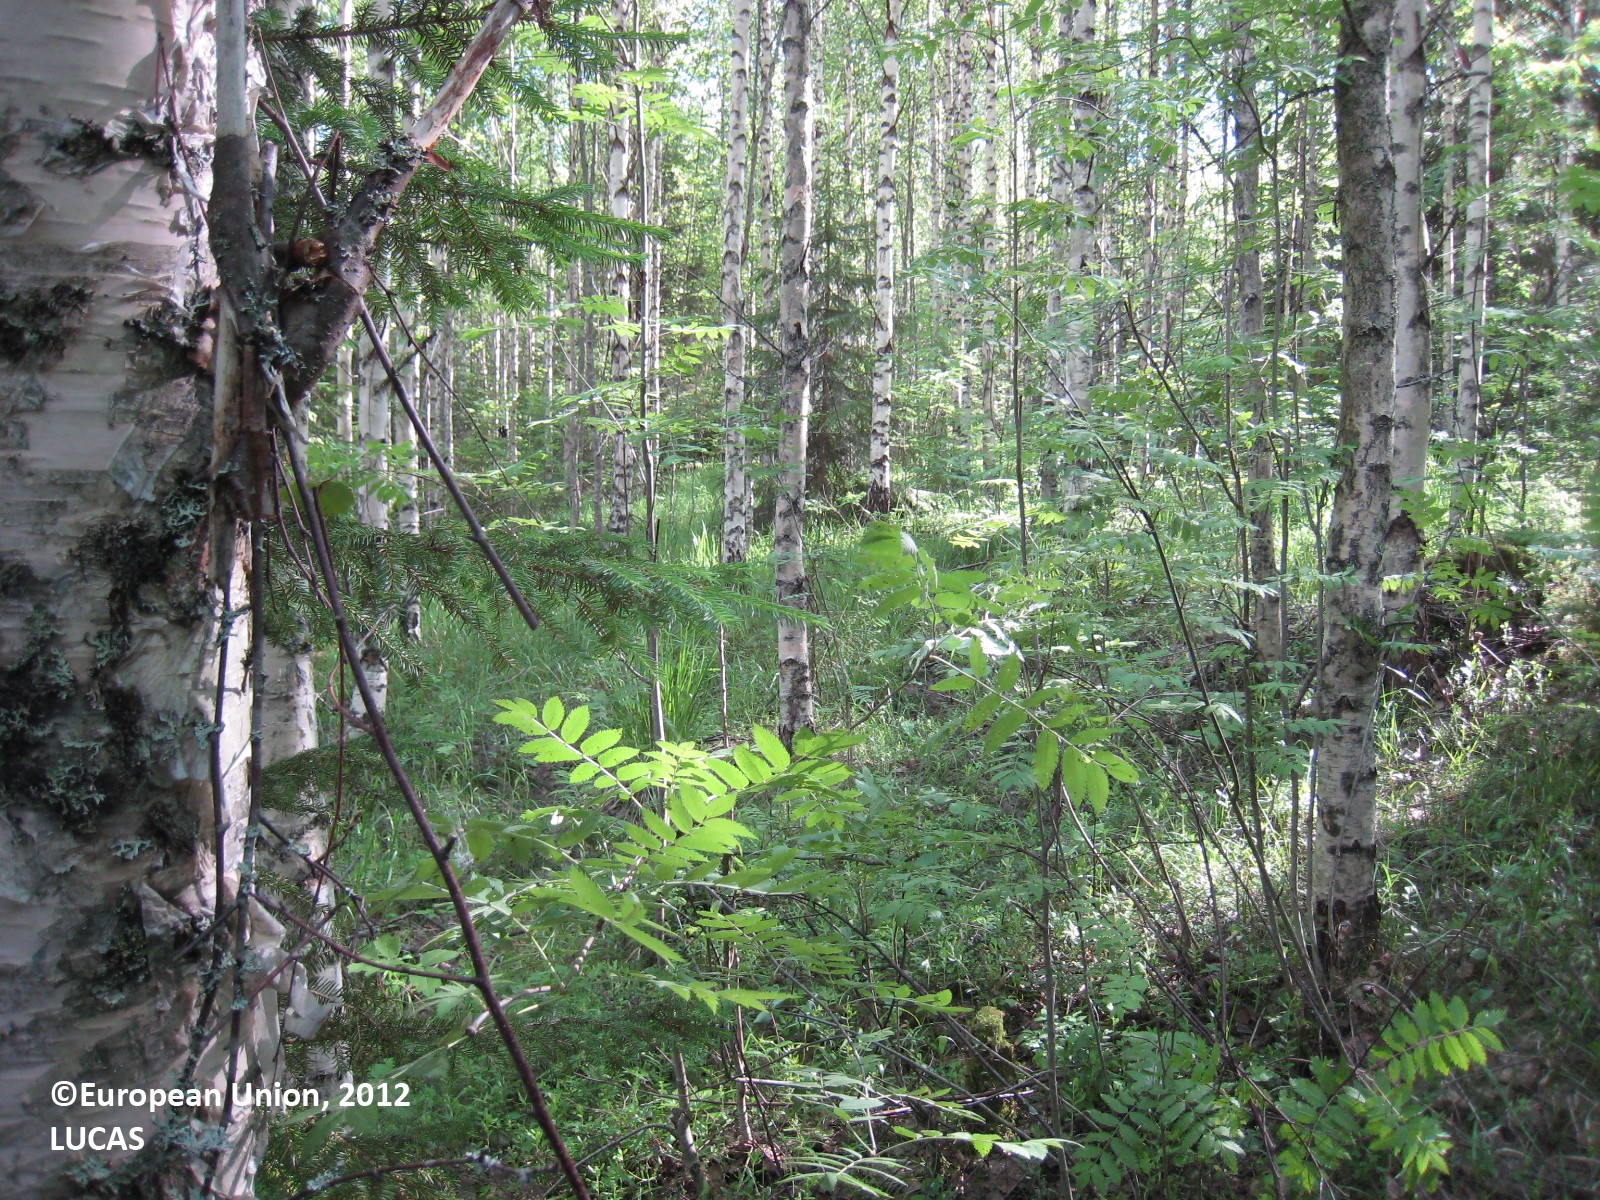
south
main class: Woodland
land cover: Spruce dominated mixed woodland
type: boreal forest
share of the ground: > 75 %
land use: Forestry
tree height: > 5 m
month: June
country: FI
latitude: 62.4575
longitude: 26.4391
